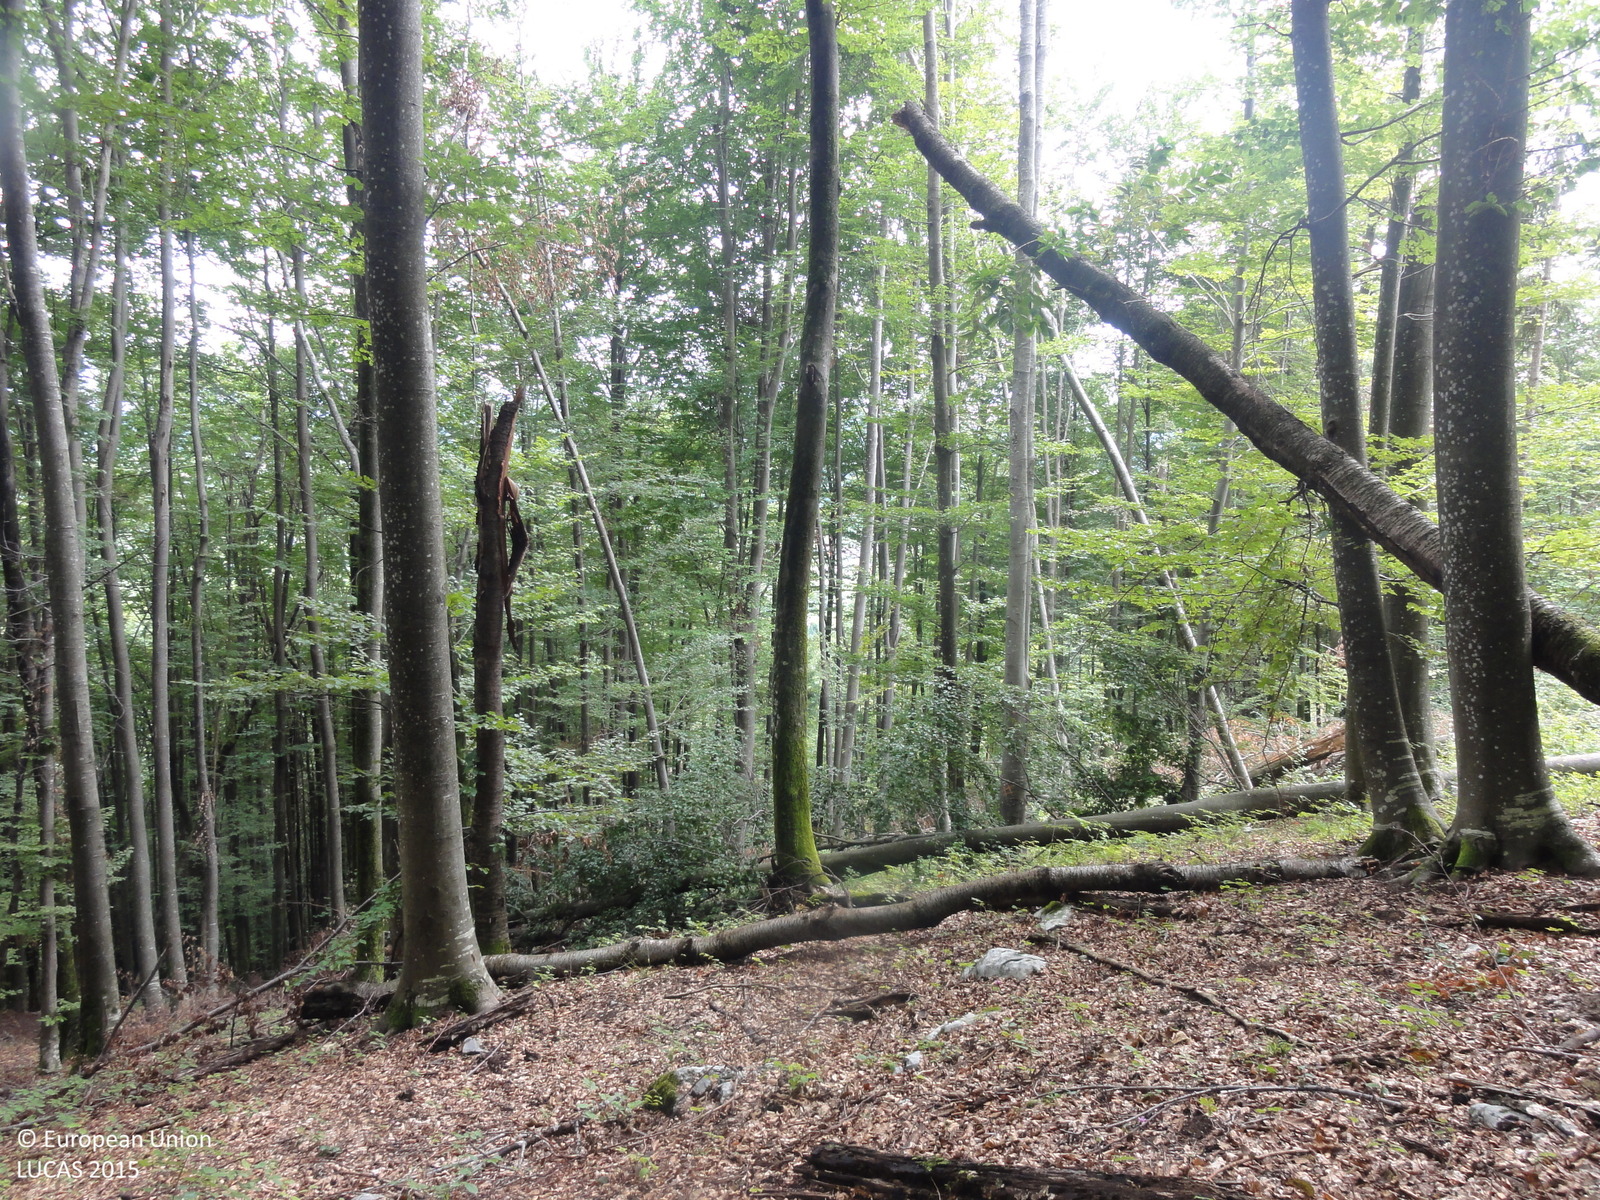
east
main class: Woodland
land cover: Broadleaved woodland
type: beech forest
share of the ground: > 75 %
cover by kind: broadleaved forest trees 95 %, shrubs 5 %
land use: Forestry
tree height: > 5 m
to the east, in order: Broadleaved woodland; Tracks; Broadleaved woodland; Spruce dominated mixed woodland; Broadleaved woodland; Artificial constructions in urban areas
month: August
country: SI
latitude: 45.7640
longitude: 15.0237
